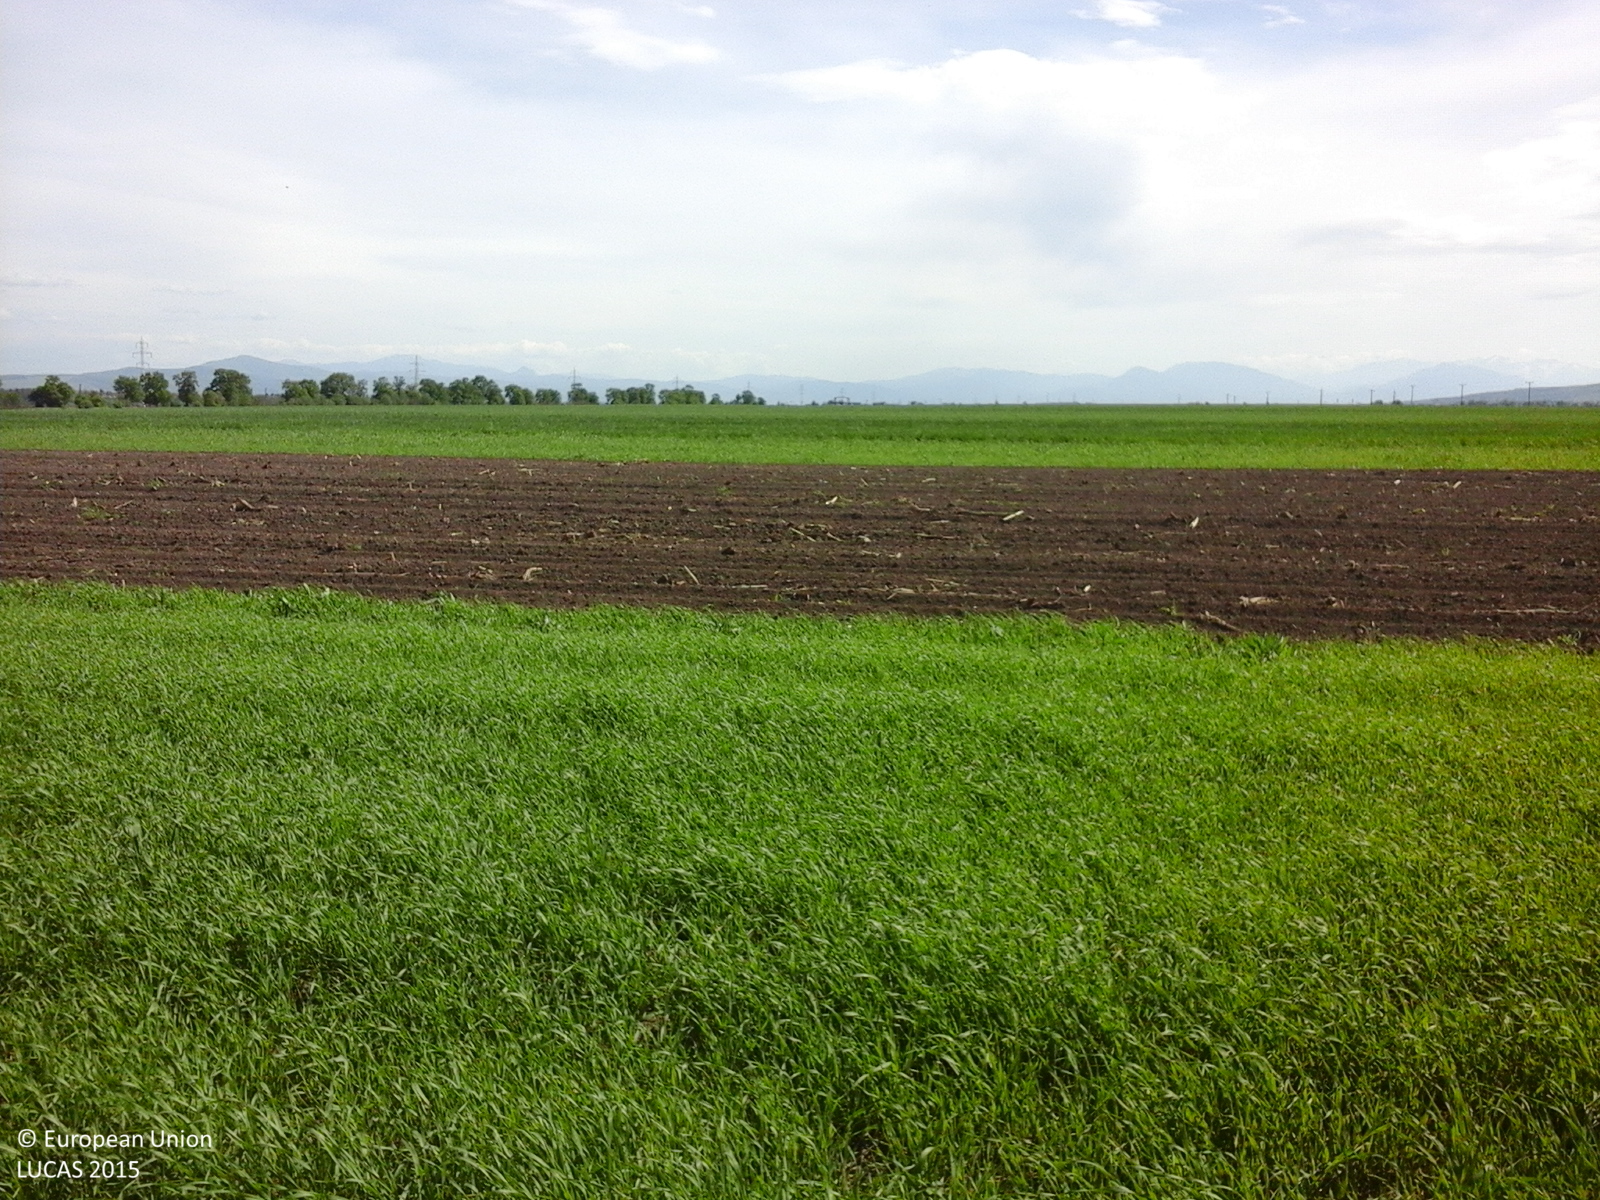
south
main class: Cropland
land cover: Common wheat
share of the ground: > 75 %
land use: Agriculture (excluding fallow land and kitchen gardens)
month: May
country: RO
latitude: 45.9327
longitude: 25.8336
